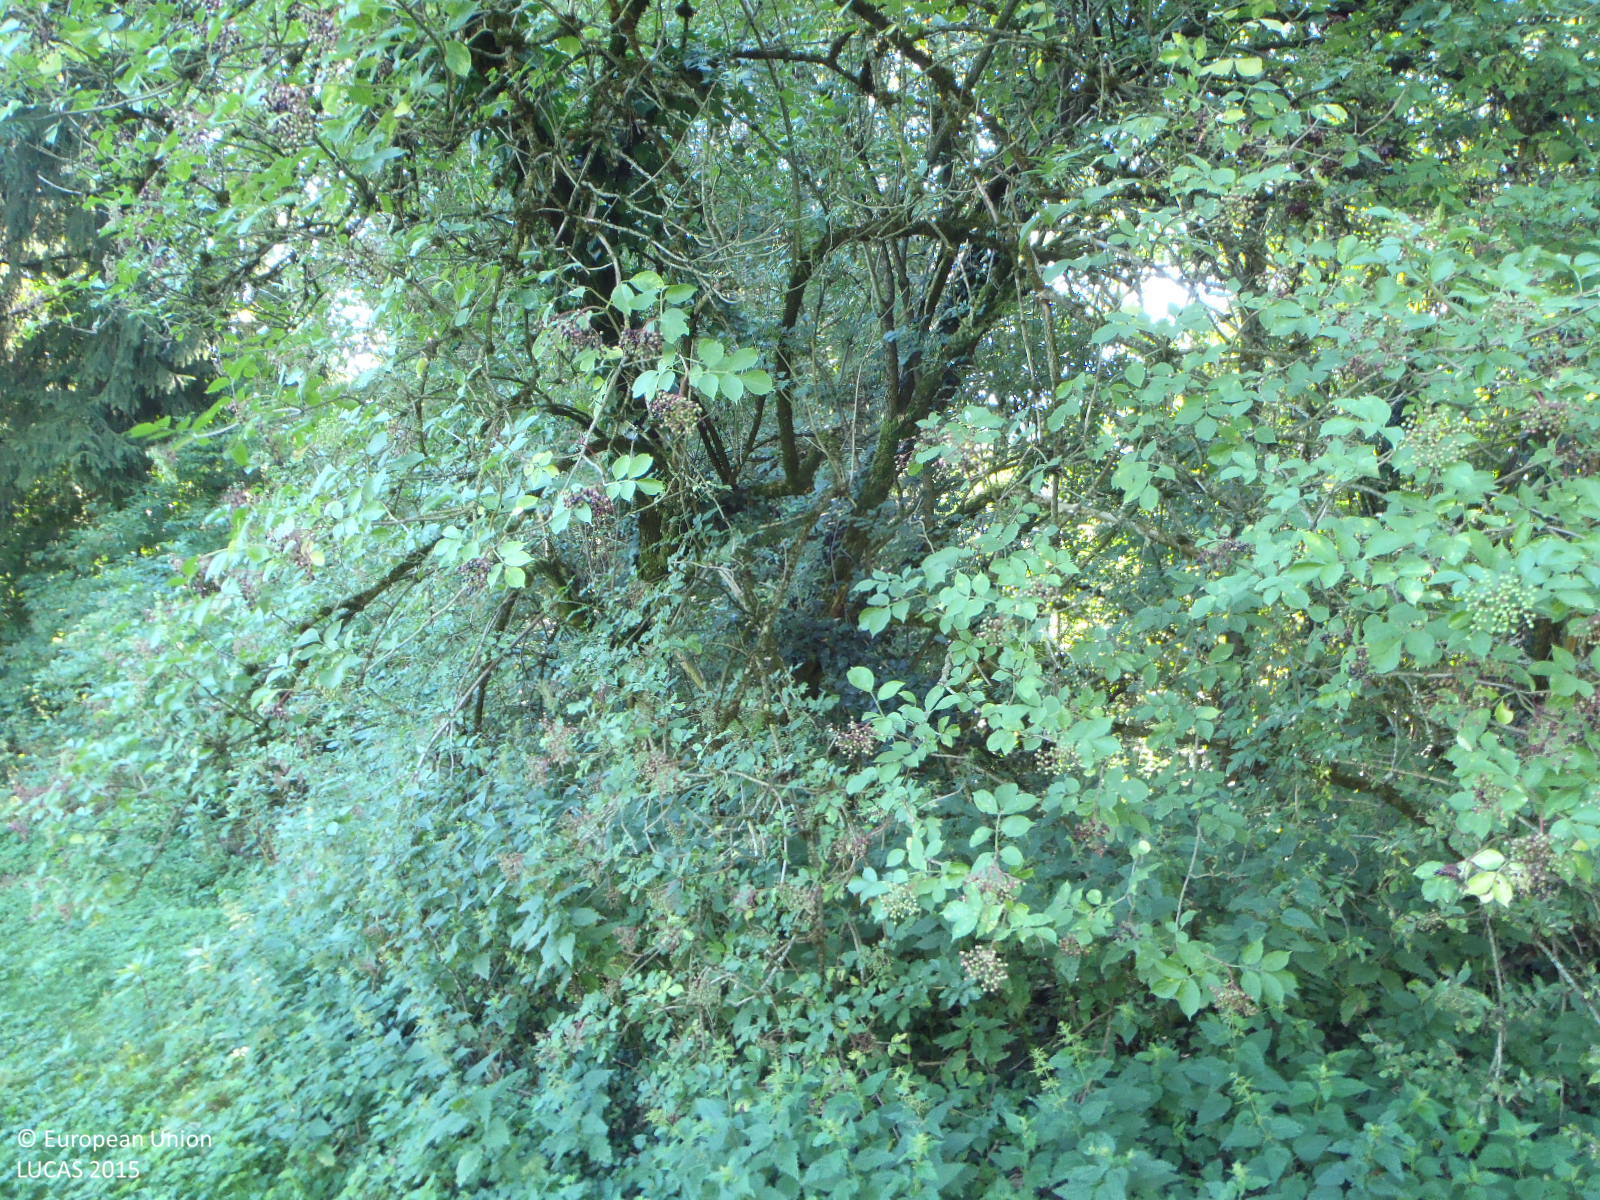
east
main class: Grassland
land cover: Grassland without tree/shrub cover
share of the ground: > 75 %
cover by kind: herbaceous plants 100 %
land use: Agriculture (excluding fallow land and kitchen gardens)
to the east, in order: Grassland without tree/shrub cover; Broadleaved woodland; Other mixed woodland; Tracks; Broadleaved woodland; Rivers and streams; Other mixed woodland; Shrubland with sparse tree cover; Paved roads, cycling and walking lanes; Grass margins; Tracks; Electric lines; Fences; Grass margins; Artificial constructions; Rivers and streams; Shrubland with sparse tree cover; Spruce dominated mixed woodland; Electric lines; Other mixed woodland
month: July
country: AT
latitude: 47.2510
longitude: 9.6436
